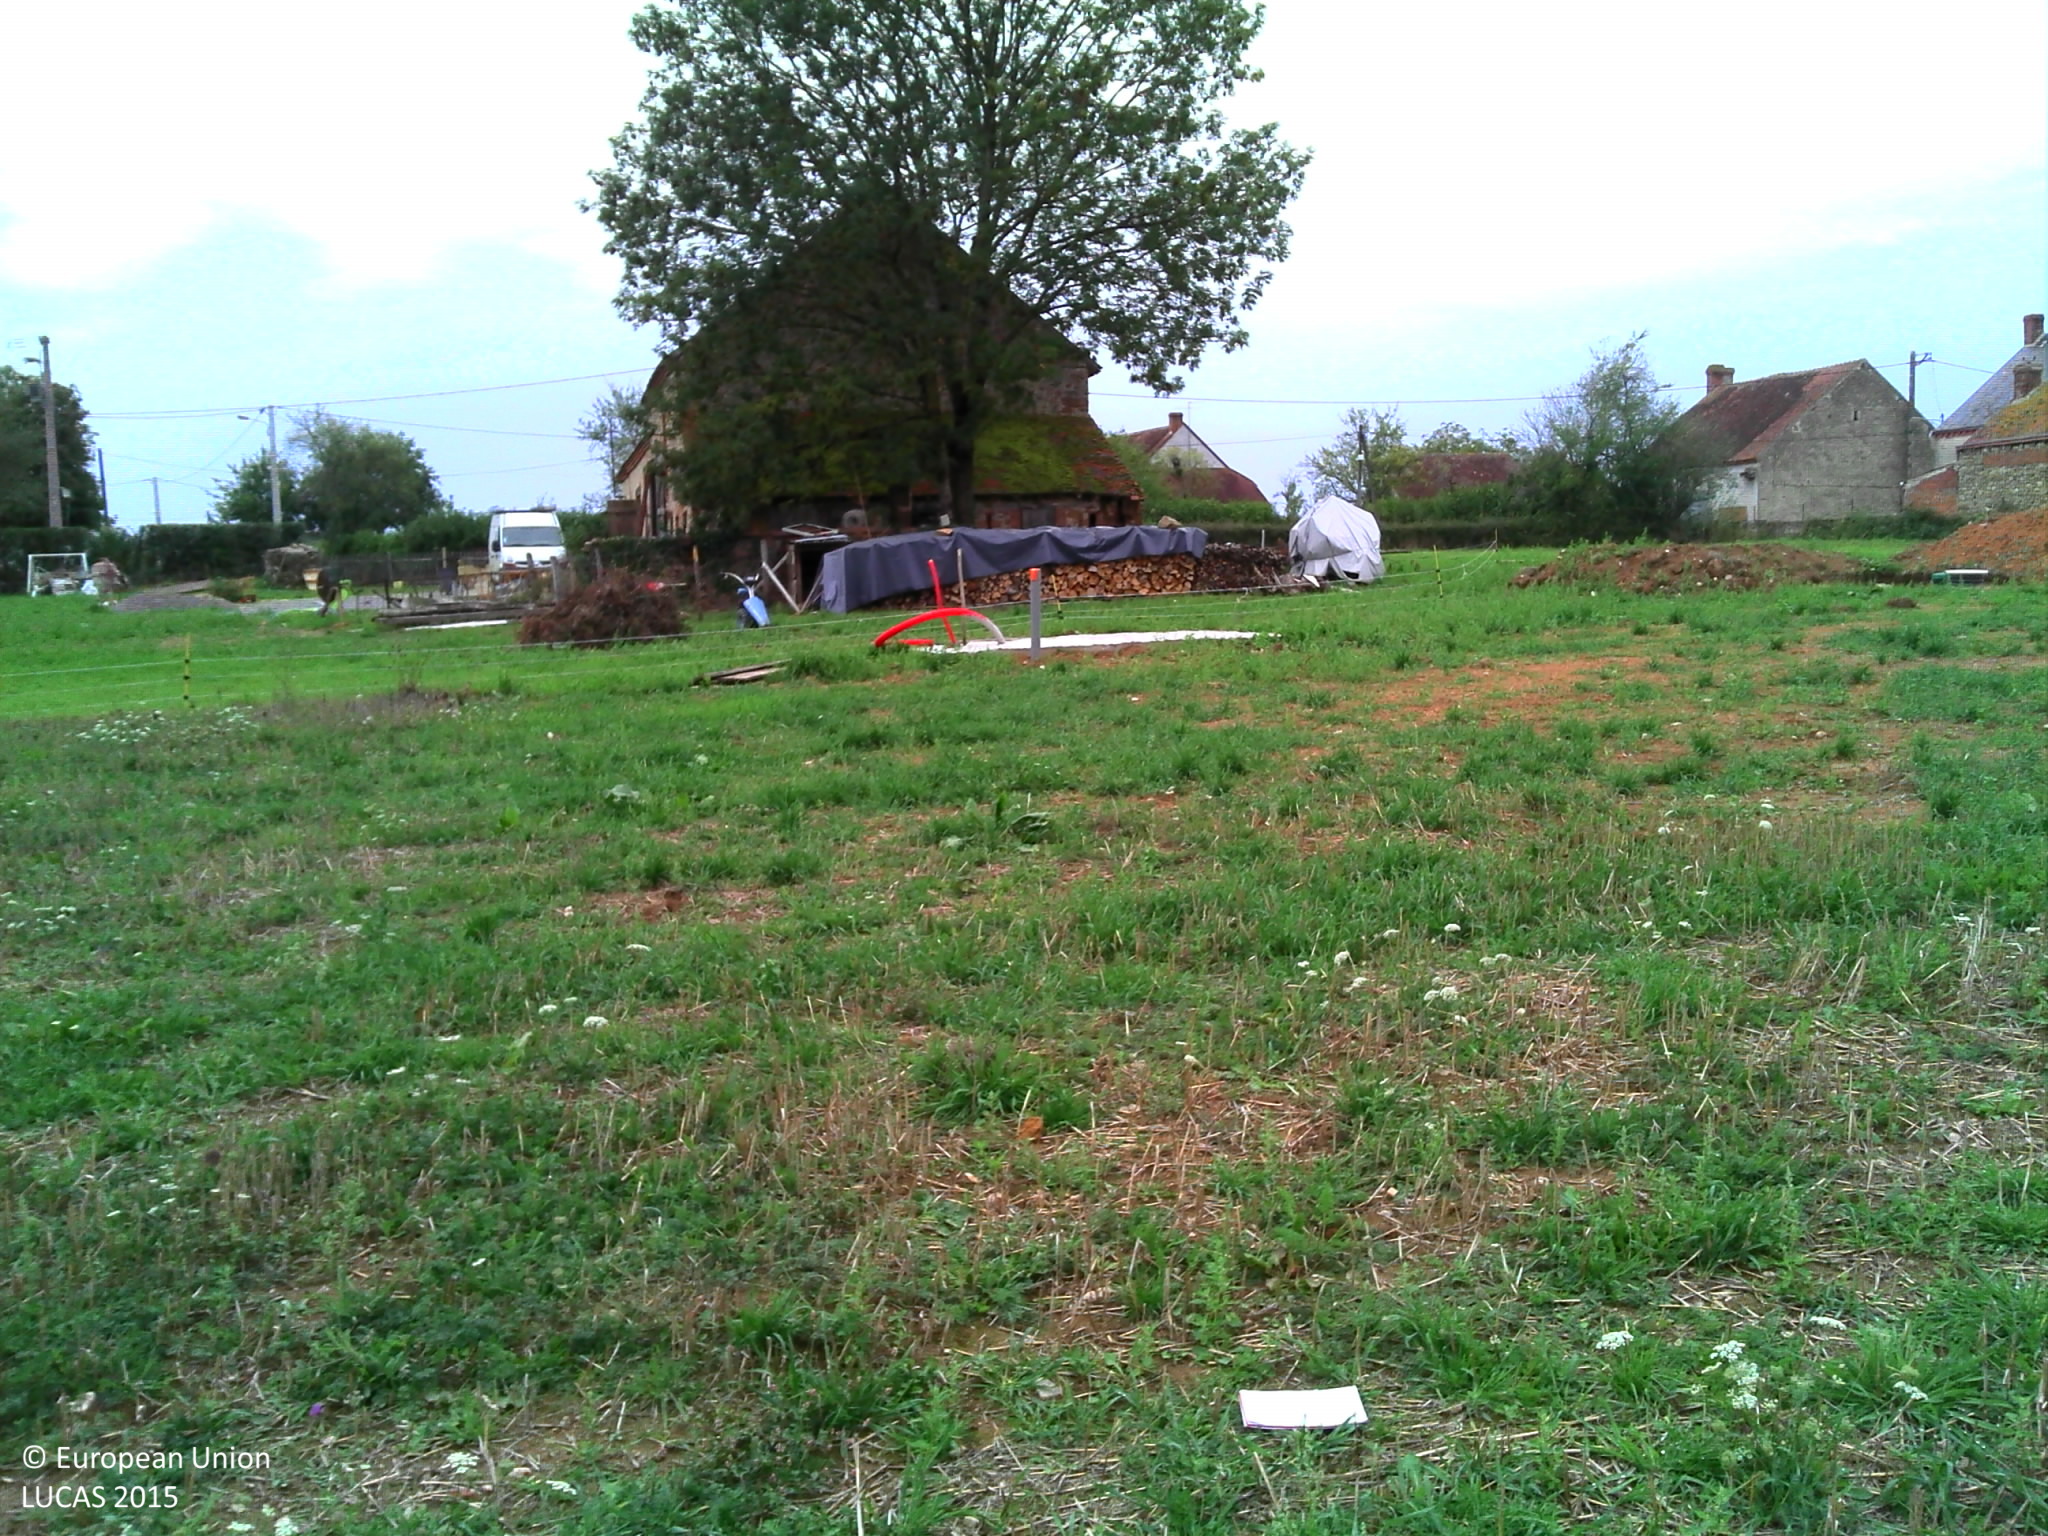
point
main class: Grassland
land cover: Spontaneously vegetated surfaces
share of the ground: 25 - 50 %
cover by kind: herbaceous plants 60 %, unconsolidated bare surface 40 %
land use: Agriculture (excluding fallow land and kitchen gardens)
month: September
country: FR
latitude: 46.5100
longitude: 1.6103
